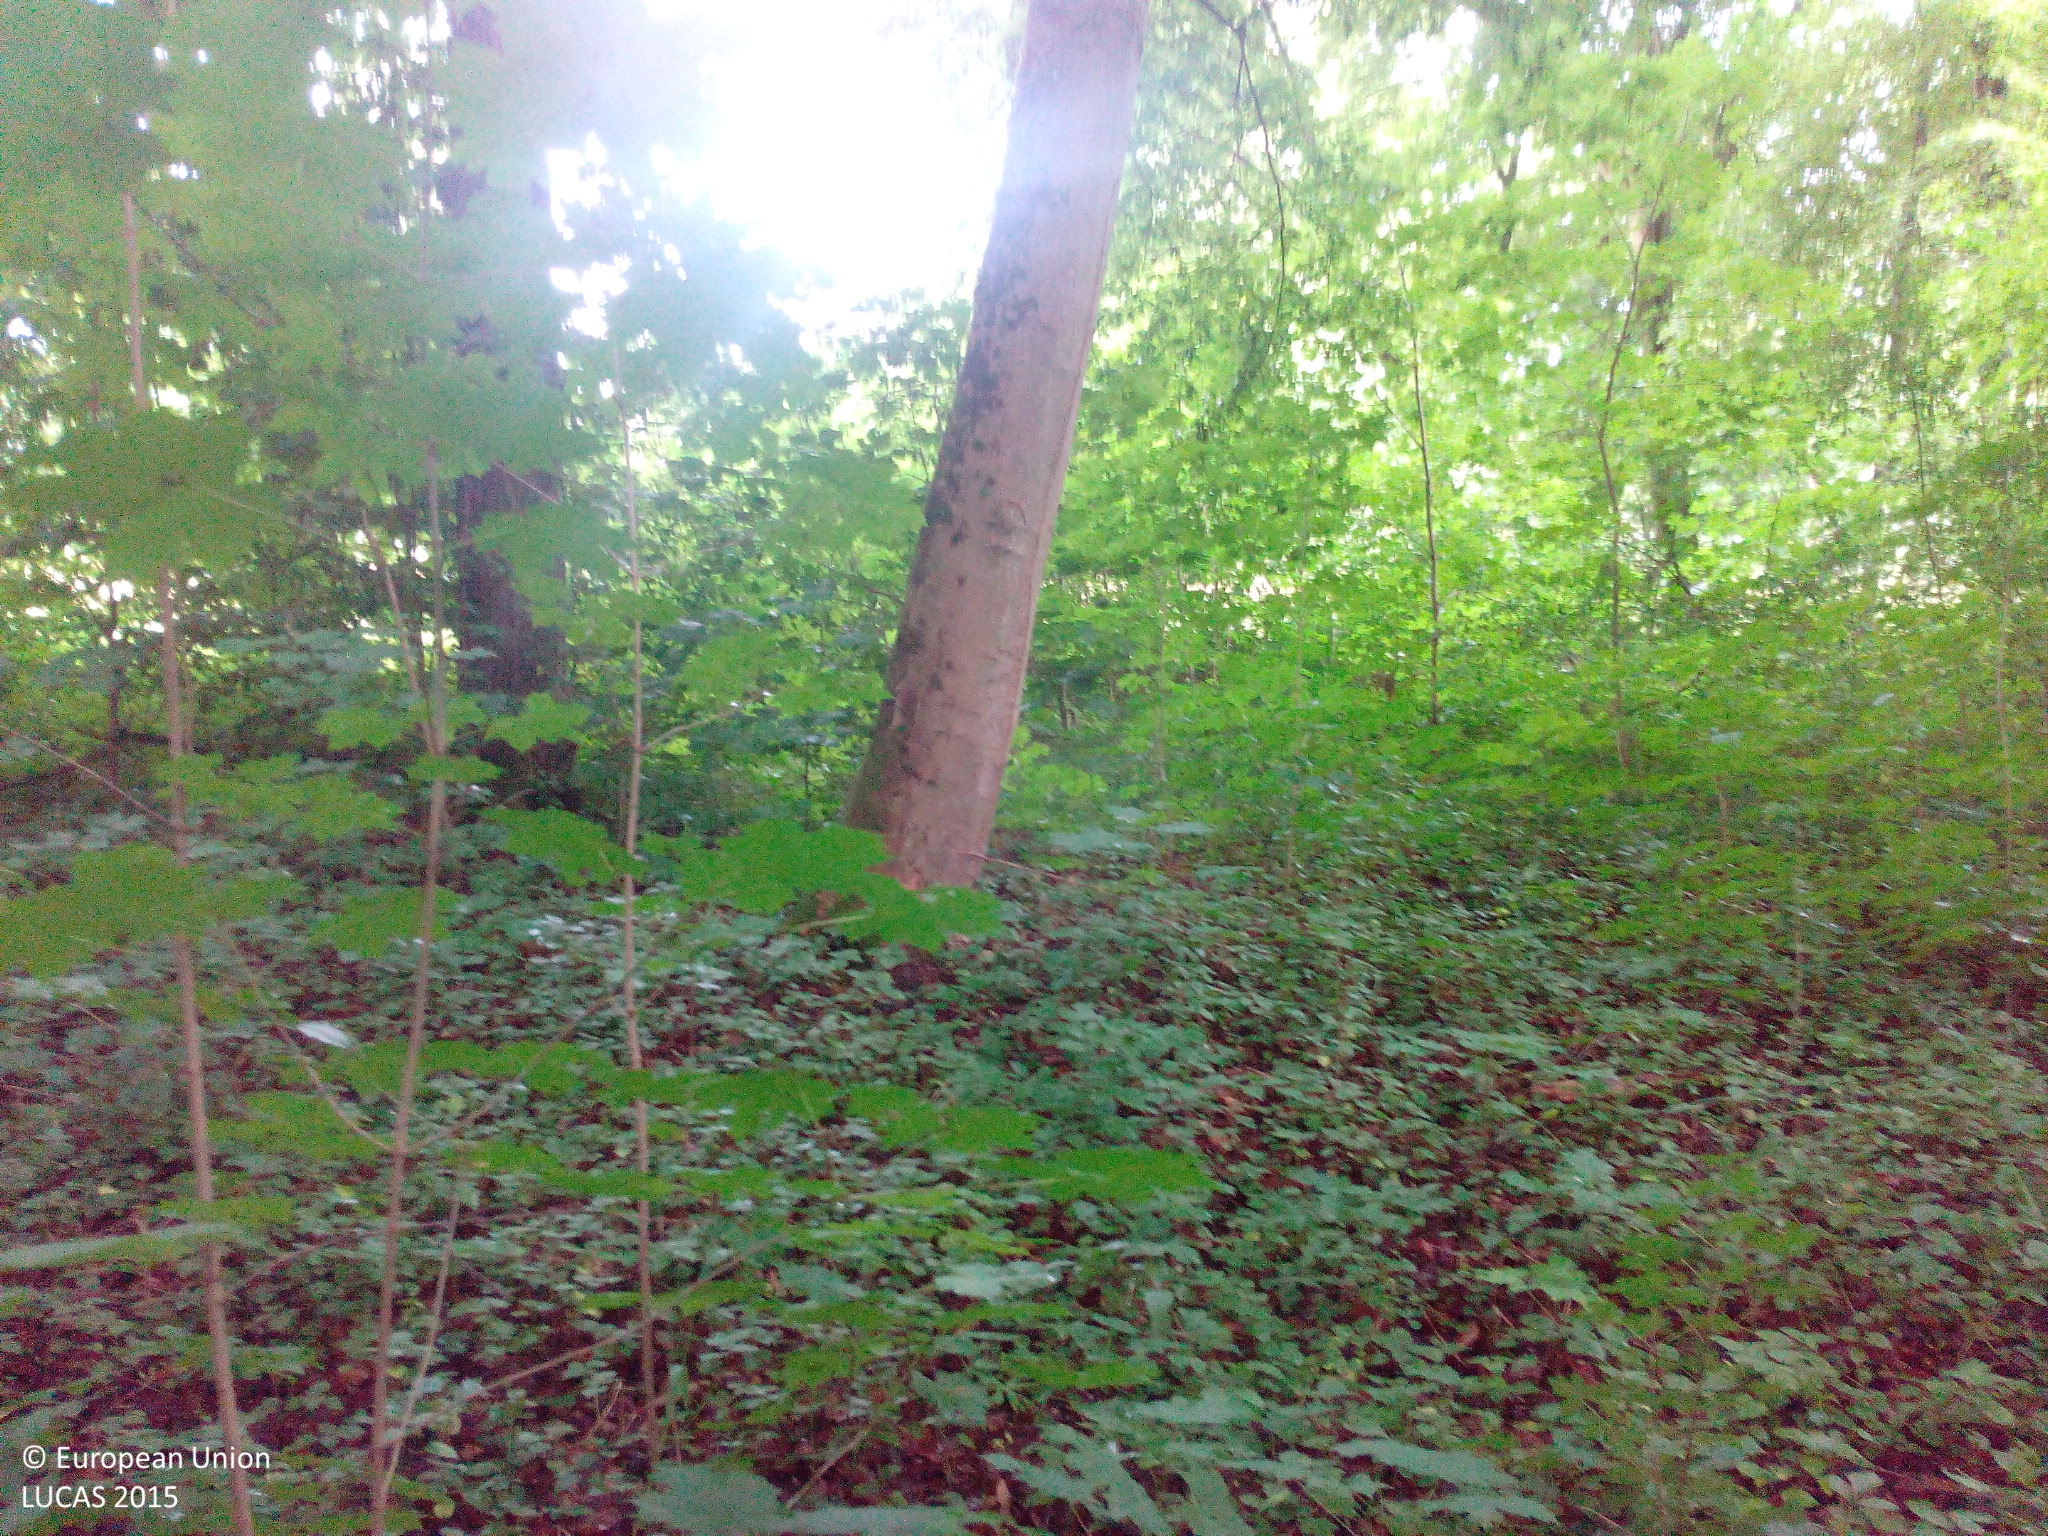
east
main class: Woodland
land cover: Broadleaved woodland
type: mesophytic deciduous forest
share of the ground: > 75 %
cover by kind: broadleaved forest trees 100 %
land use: Amenities, museums, leisure
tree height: > 5 m
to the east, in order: Broadleaved woodland; Tracks; Single bushes/trees; Grassland without tree/shrub cover; Tracks; Broadleaved woodland; Tracks; Broadleaved woodland; Inland fresh running water; Shruby margins; Tracks; Lines of trees; Paved roads, cycling and walking lanes; Grass margins; Fences; Abandoned hedges; Grassland without tree/shrub cover; Single bushes/trees; Grassland without tree/shrub cover
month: June
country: DE
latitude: 49.8749
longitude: 10.9042
